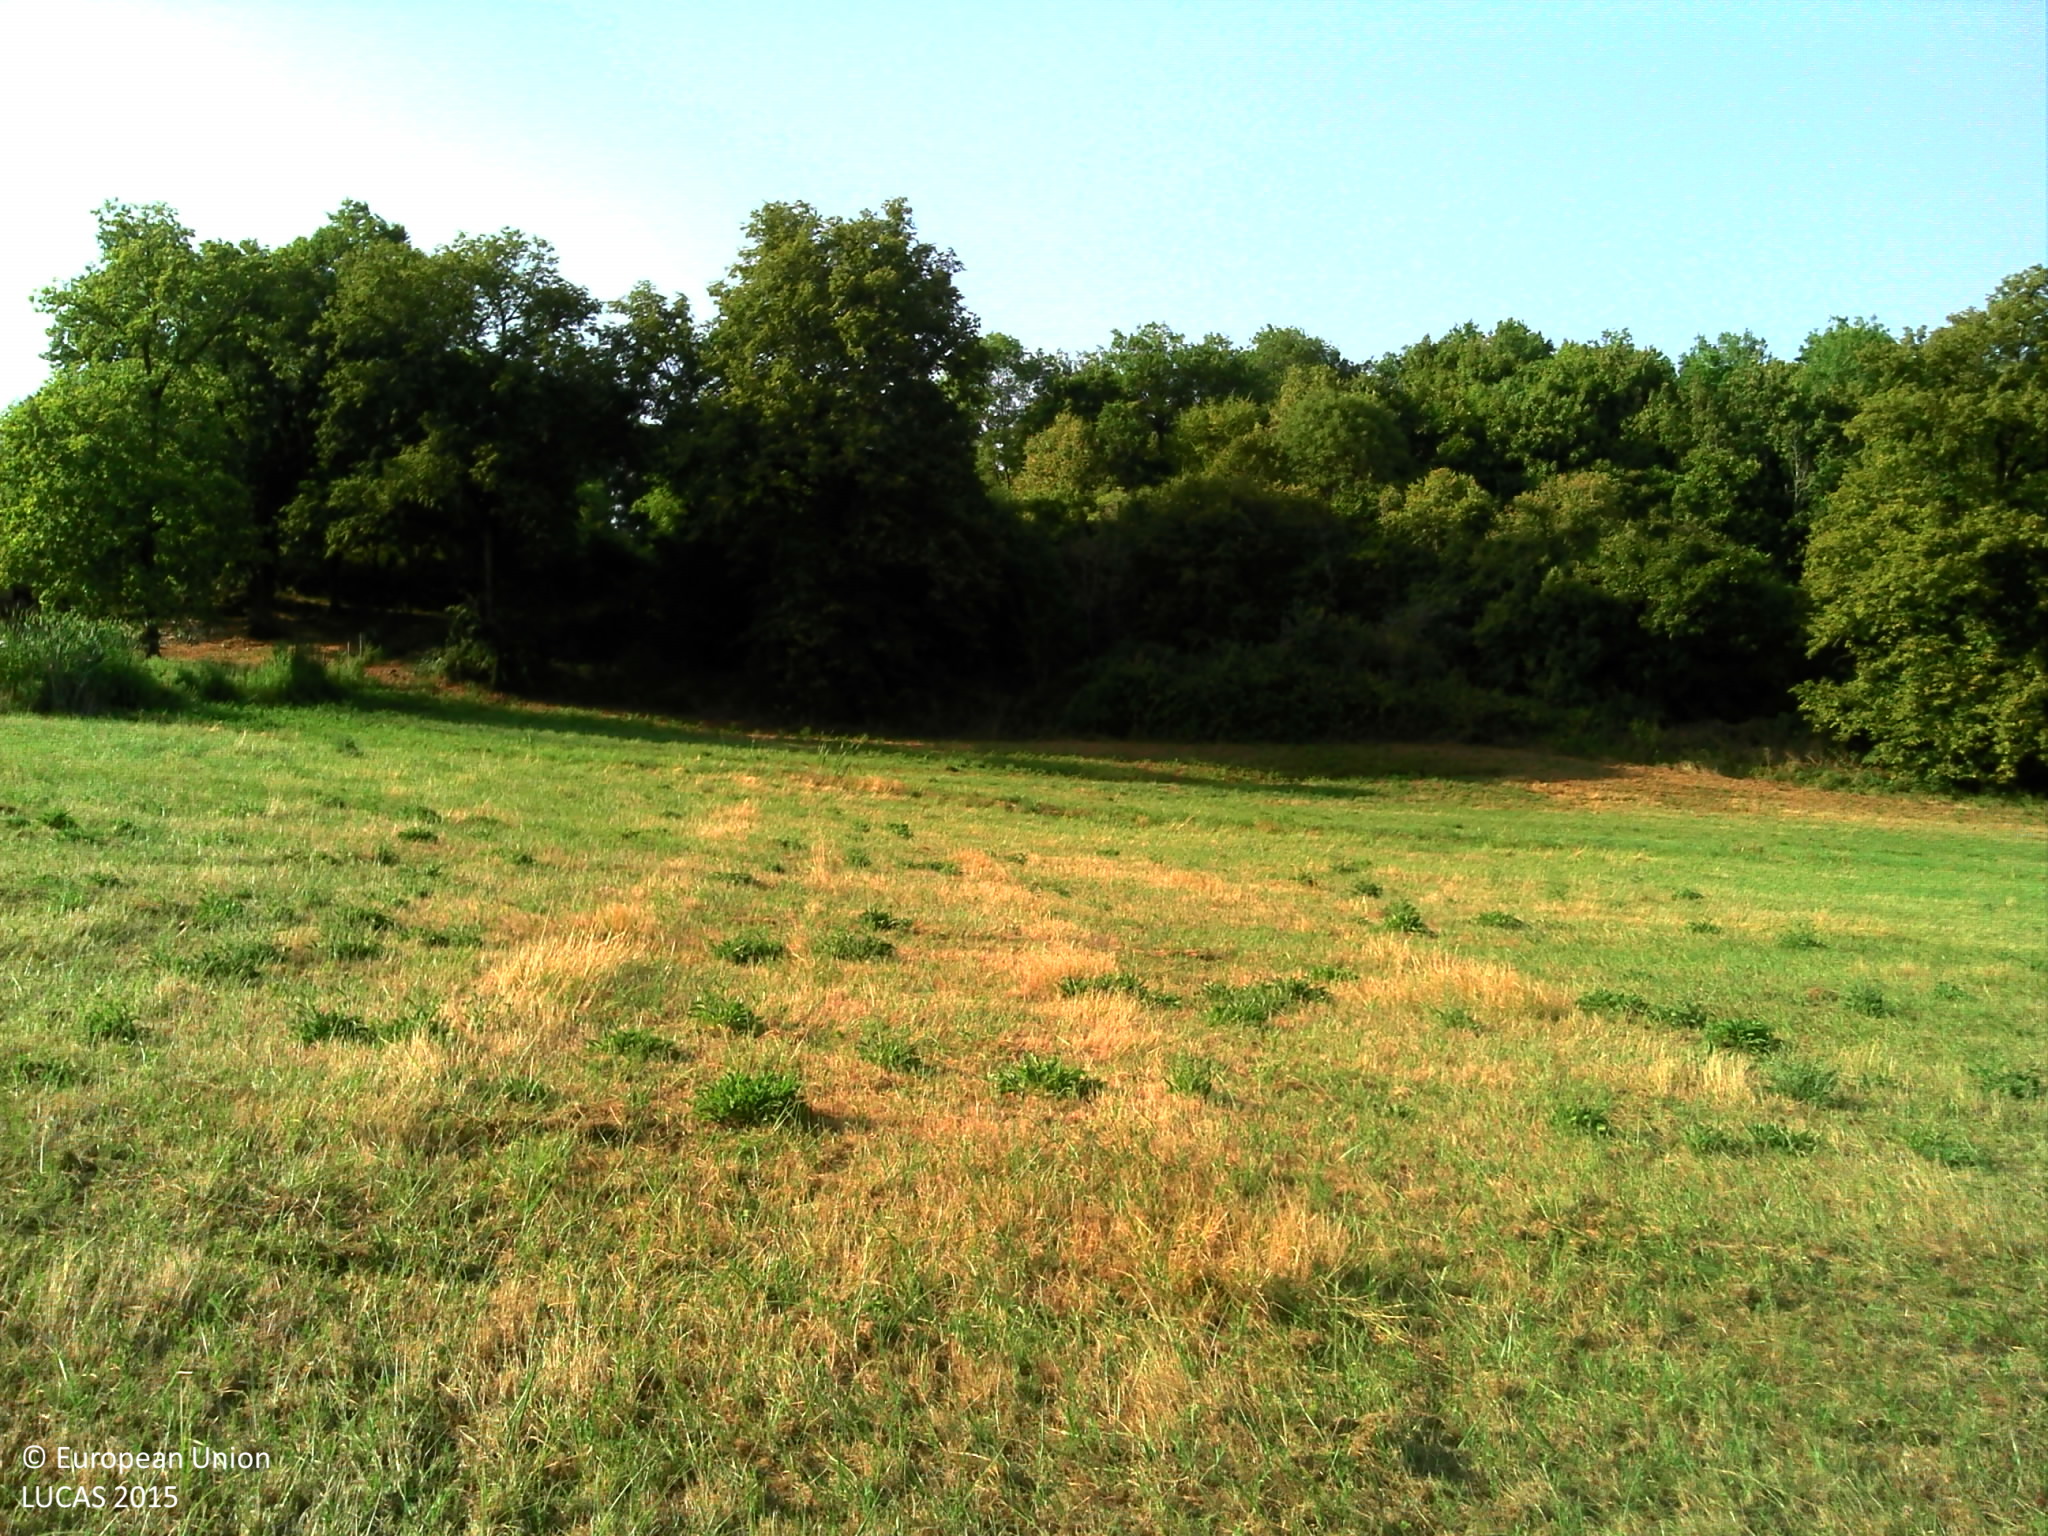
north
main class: Grassland
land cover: Grassland without tree/shrub cover
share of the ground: > 75 %
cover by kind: herbaceous plants 100 %
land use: Agriculture (excluding fallow land and kitchen gardens)
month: July
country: FR
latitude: 45.2893
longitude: 1.0797
